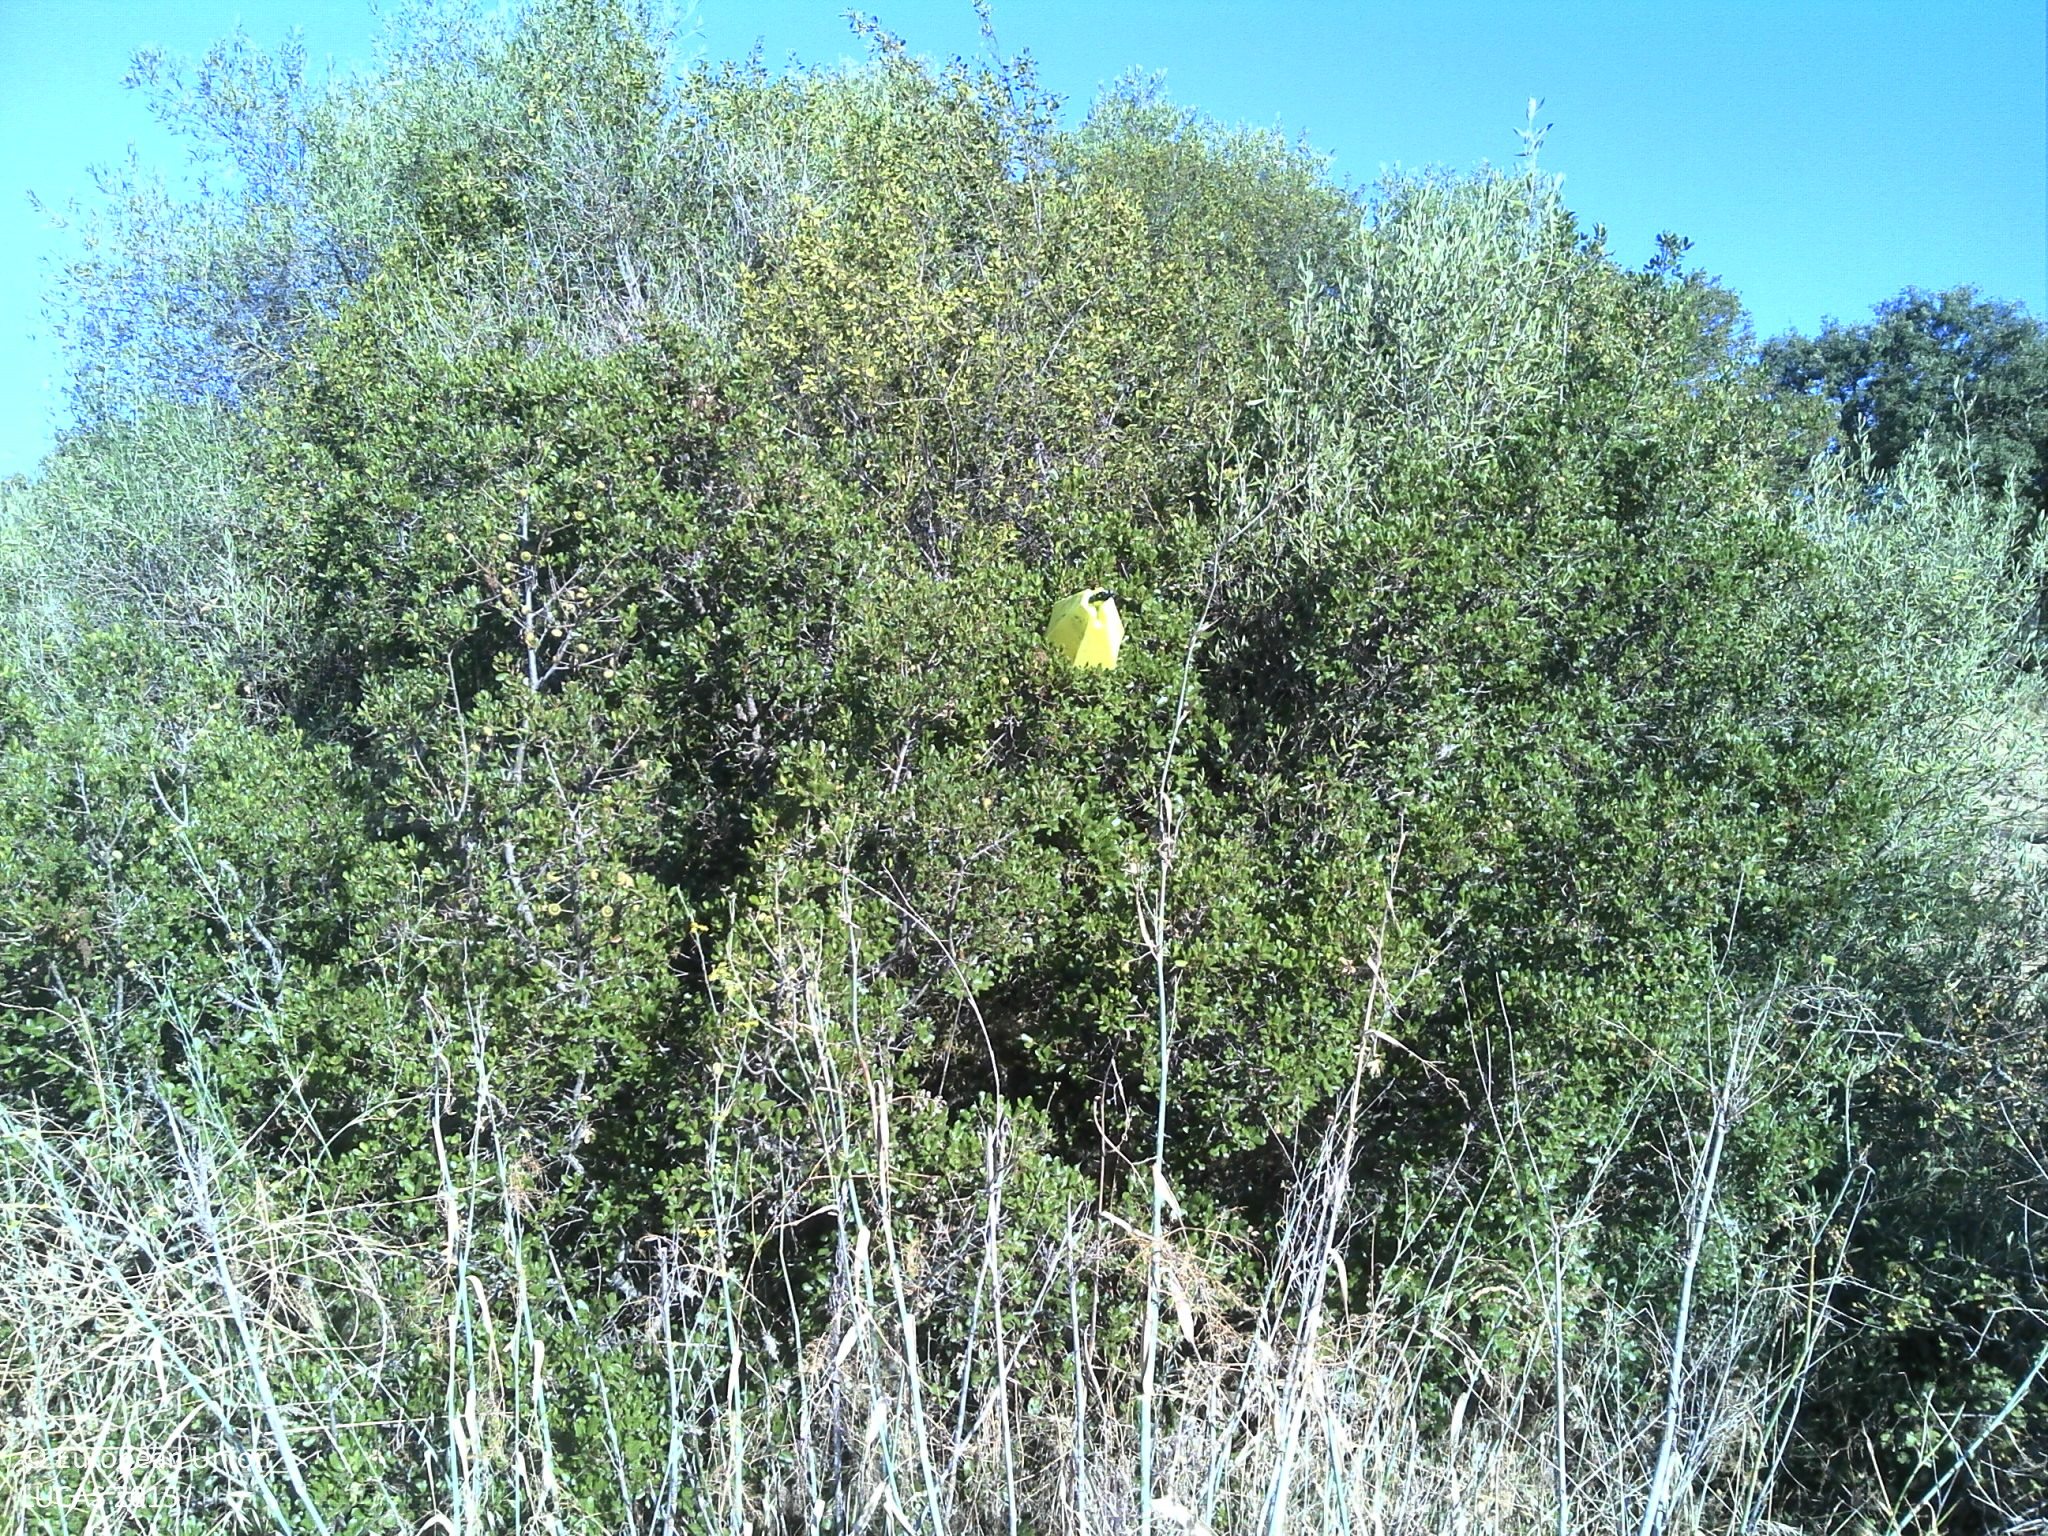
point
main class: Cropland
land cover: Olive groves
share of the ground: 25 - 50 %
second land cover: Shrubland without tree cover
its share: 10 - 25 %
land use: Agriculture (excluding fallow land and kitchen gardens)
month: July
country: PT
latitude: 39.0967
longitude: -7.0374
